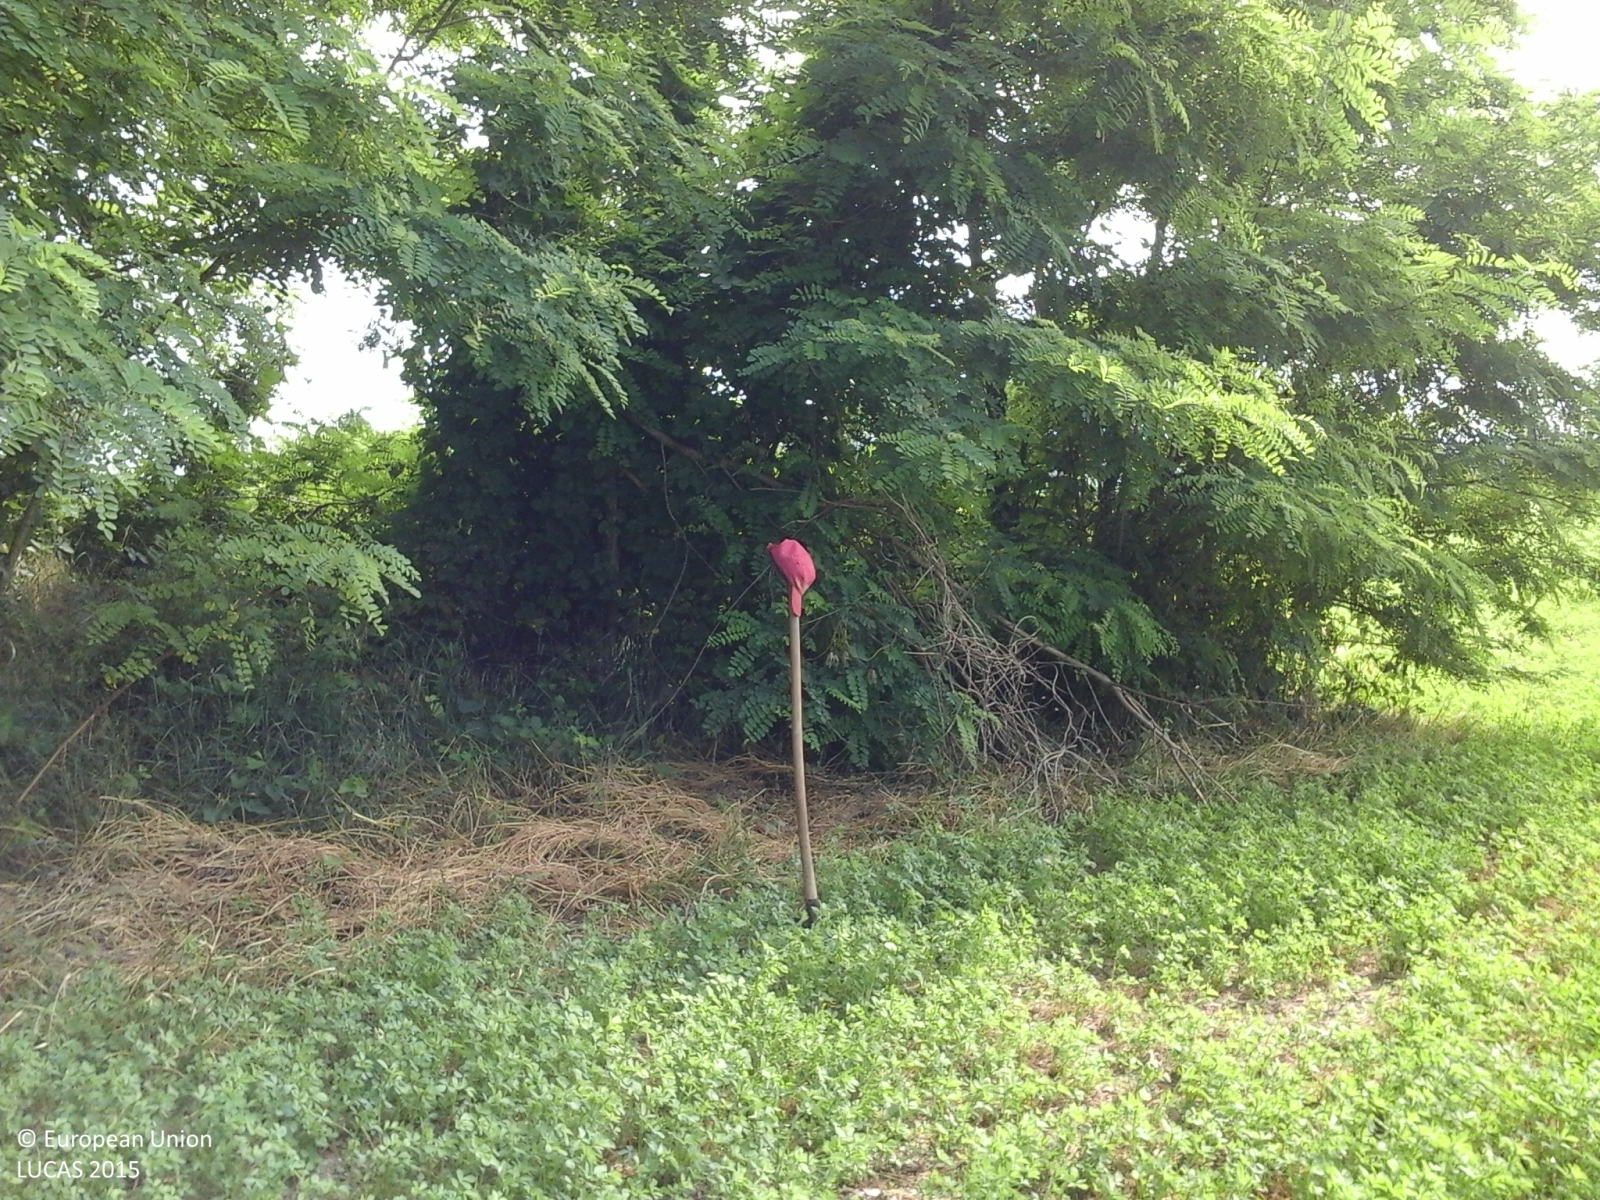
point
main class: Cropland
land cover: Lucerne
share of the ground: > 75 %
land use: Agriculture (excluding fallow land and kitchen gardens)
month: June
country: IT
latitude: 45.0898
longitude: 10.0127
